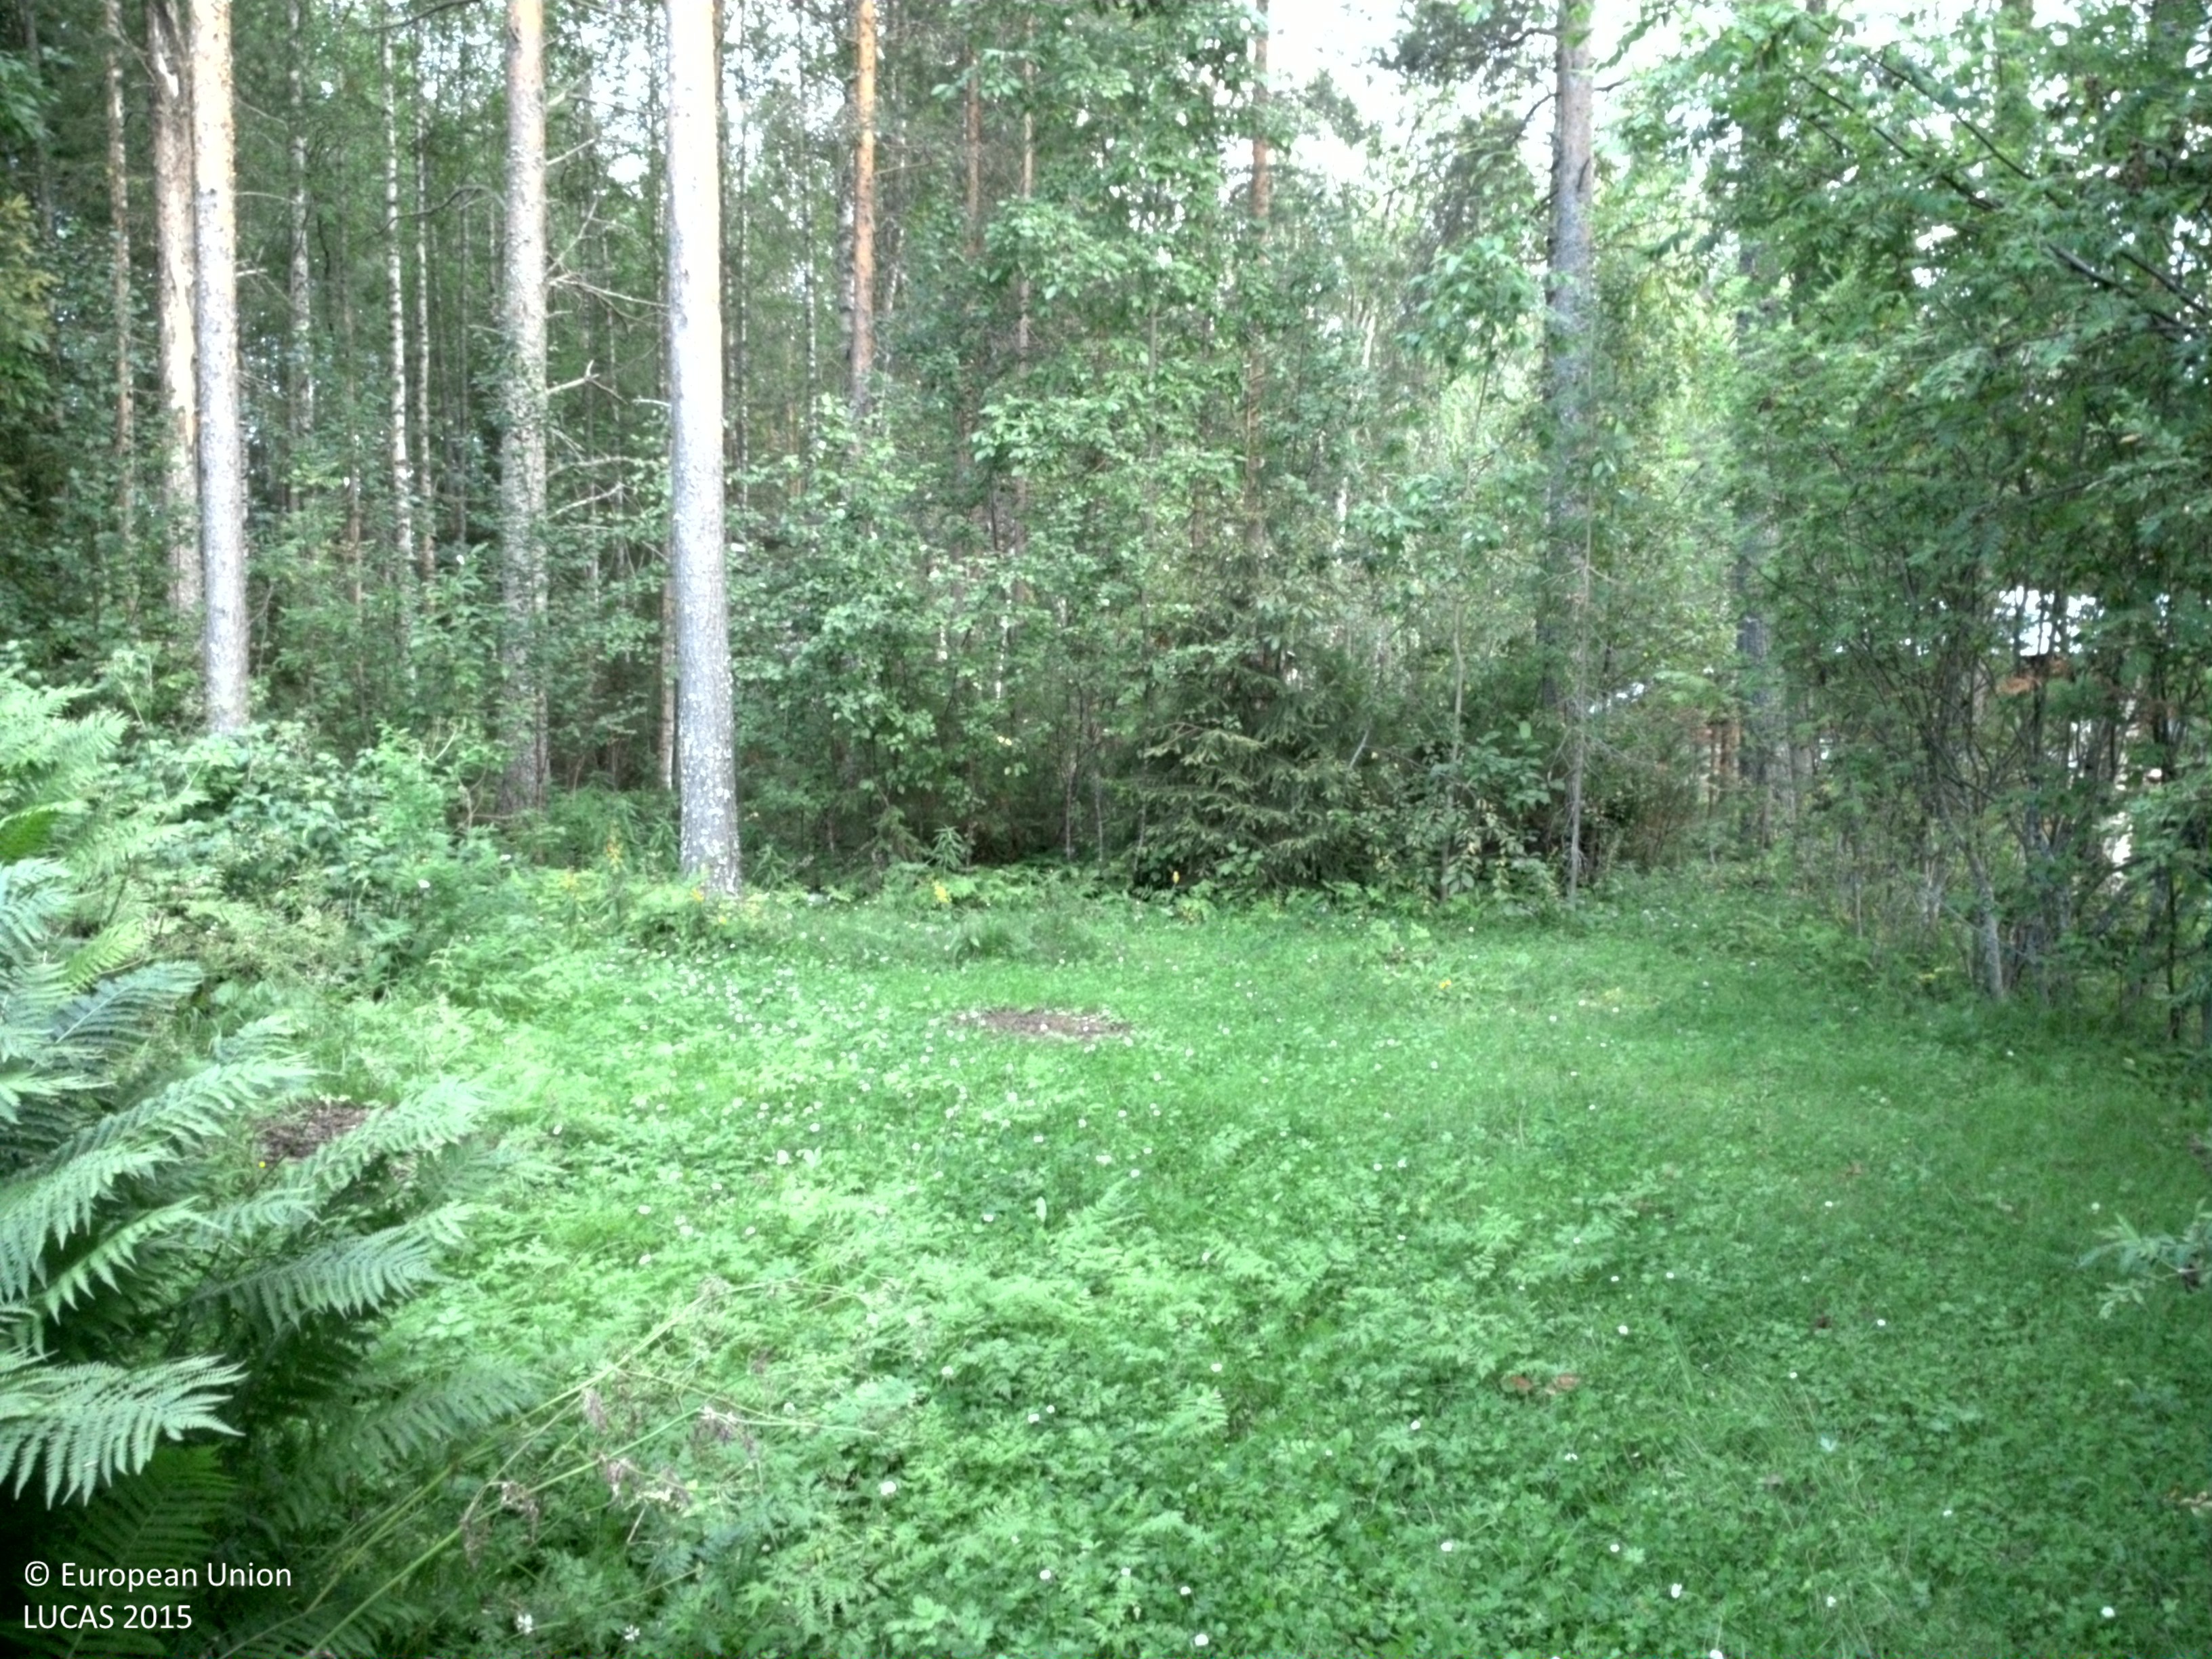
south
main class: Grassland
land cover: Grassland without tree/shrub cover
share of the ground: > 75 %
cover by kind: herbaceous plants 100 %
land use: Residential
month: August
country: SE
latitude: 66.2809
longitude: 22.8331
